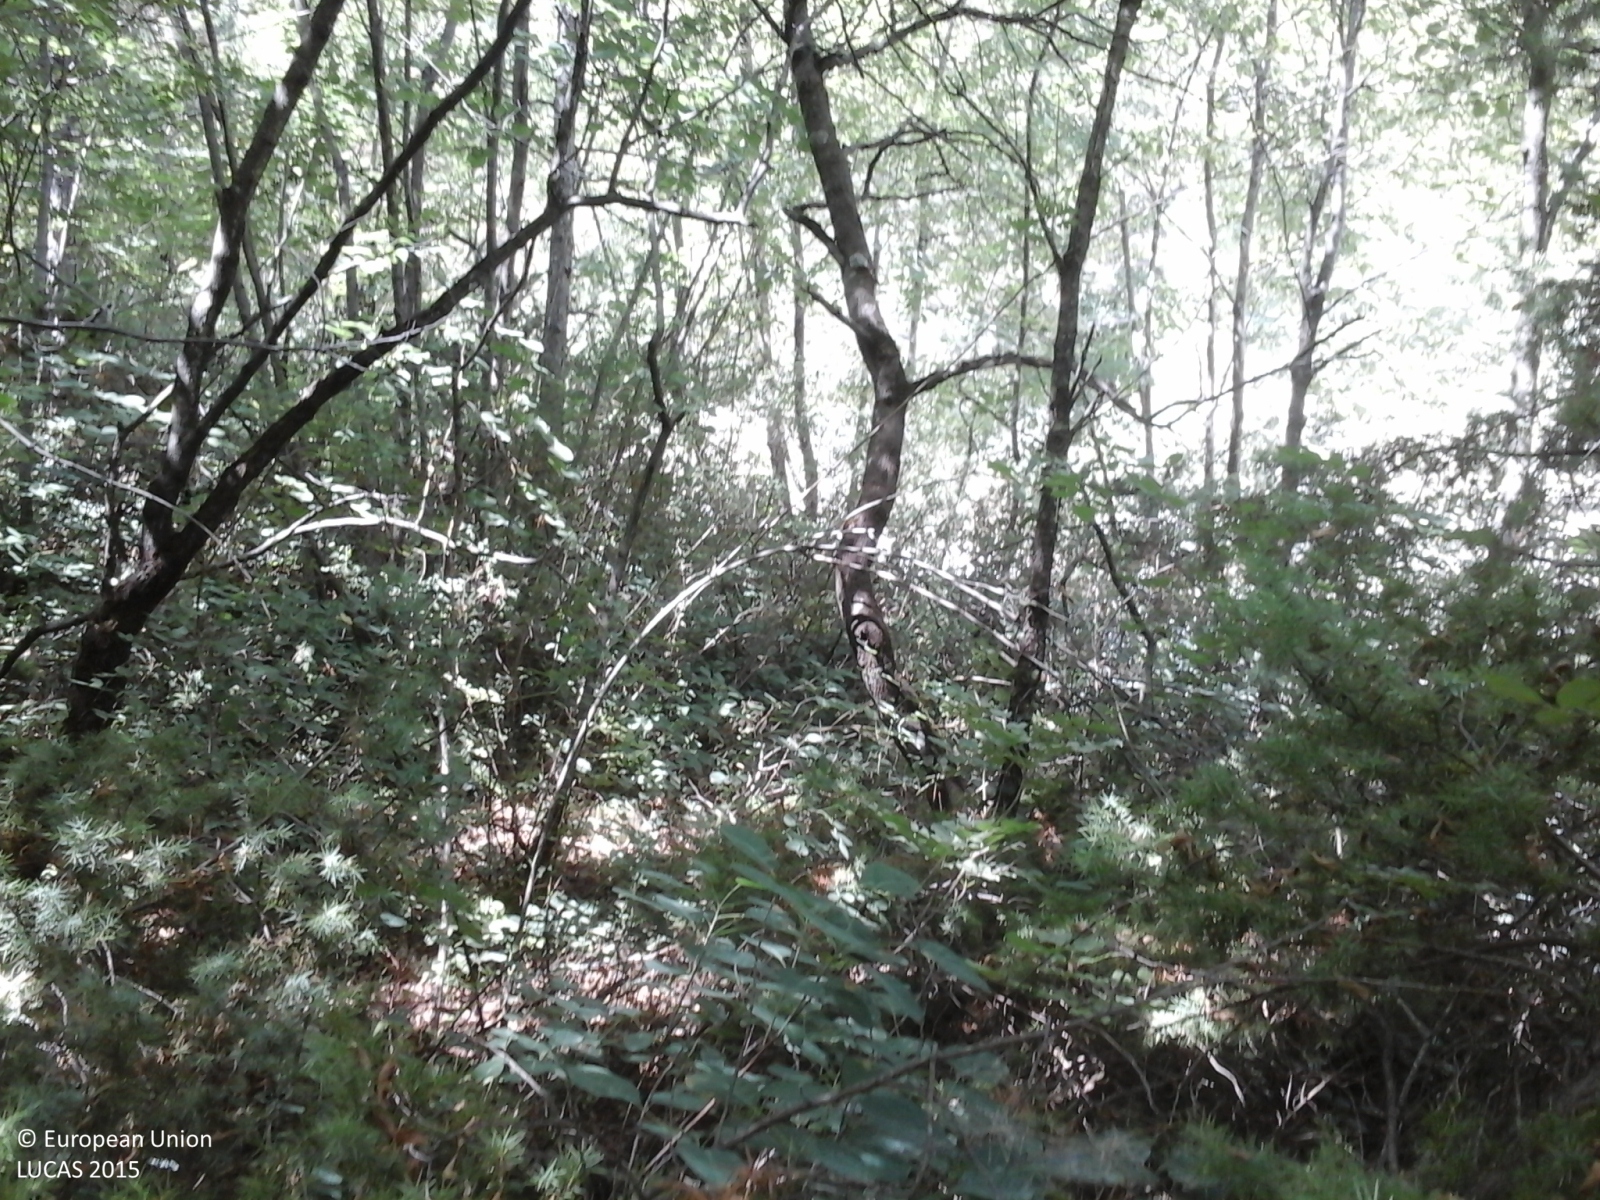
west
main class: Woodland
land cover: Broadleaved woodland
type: mountainous beech forest
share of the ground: > 75 %
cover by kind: broadleaved forest trees 95 %, coniferous forest trees 5 %
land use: Forestry
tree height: > 5 m
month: August
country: IT
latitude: 43.3071
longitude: 13.2339
